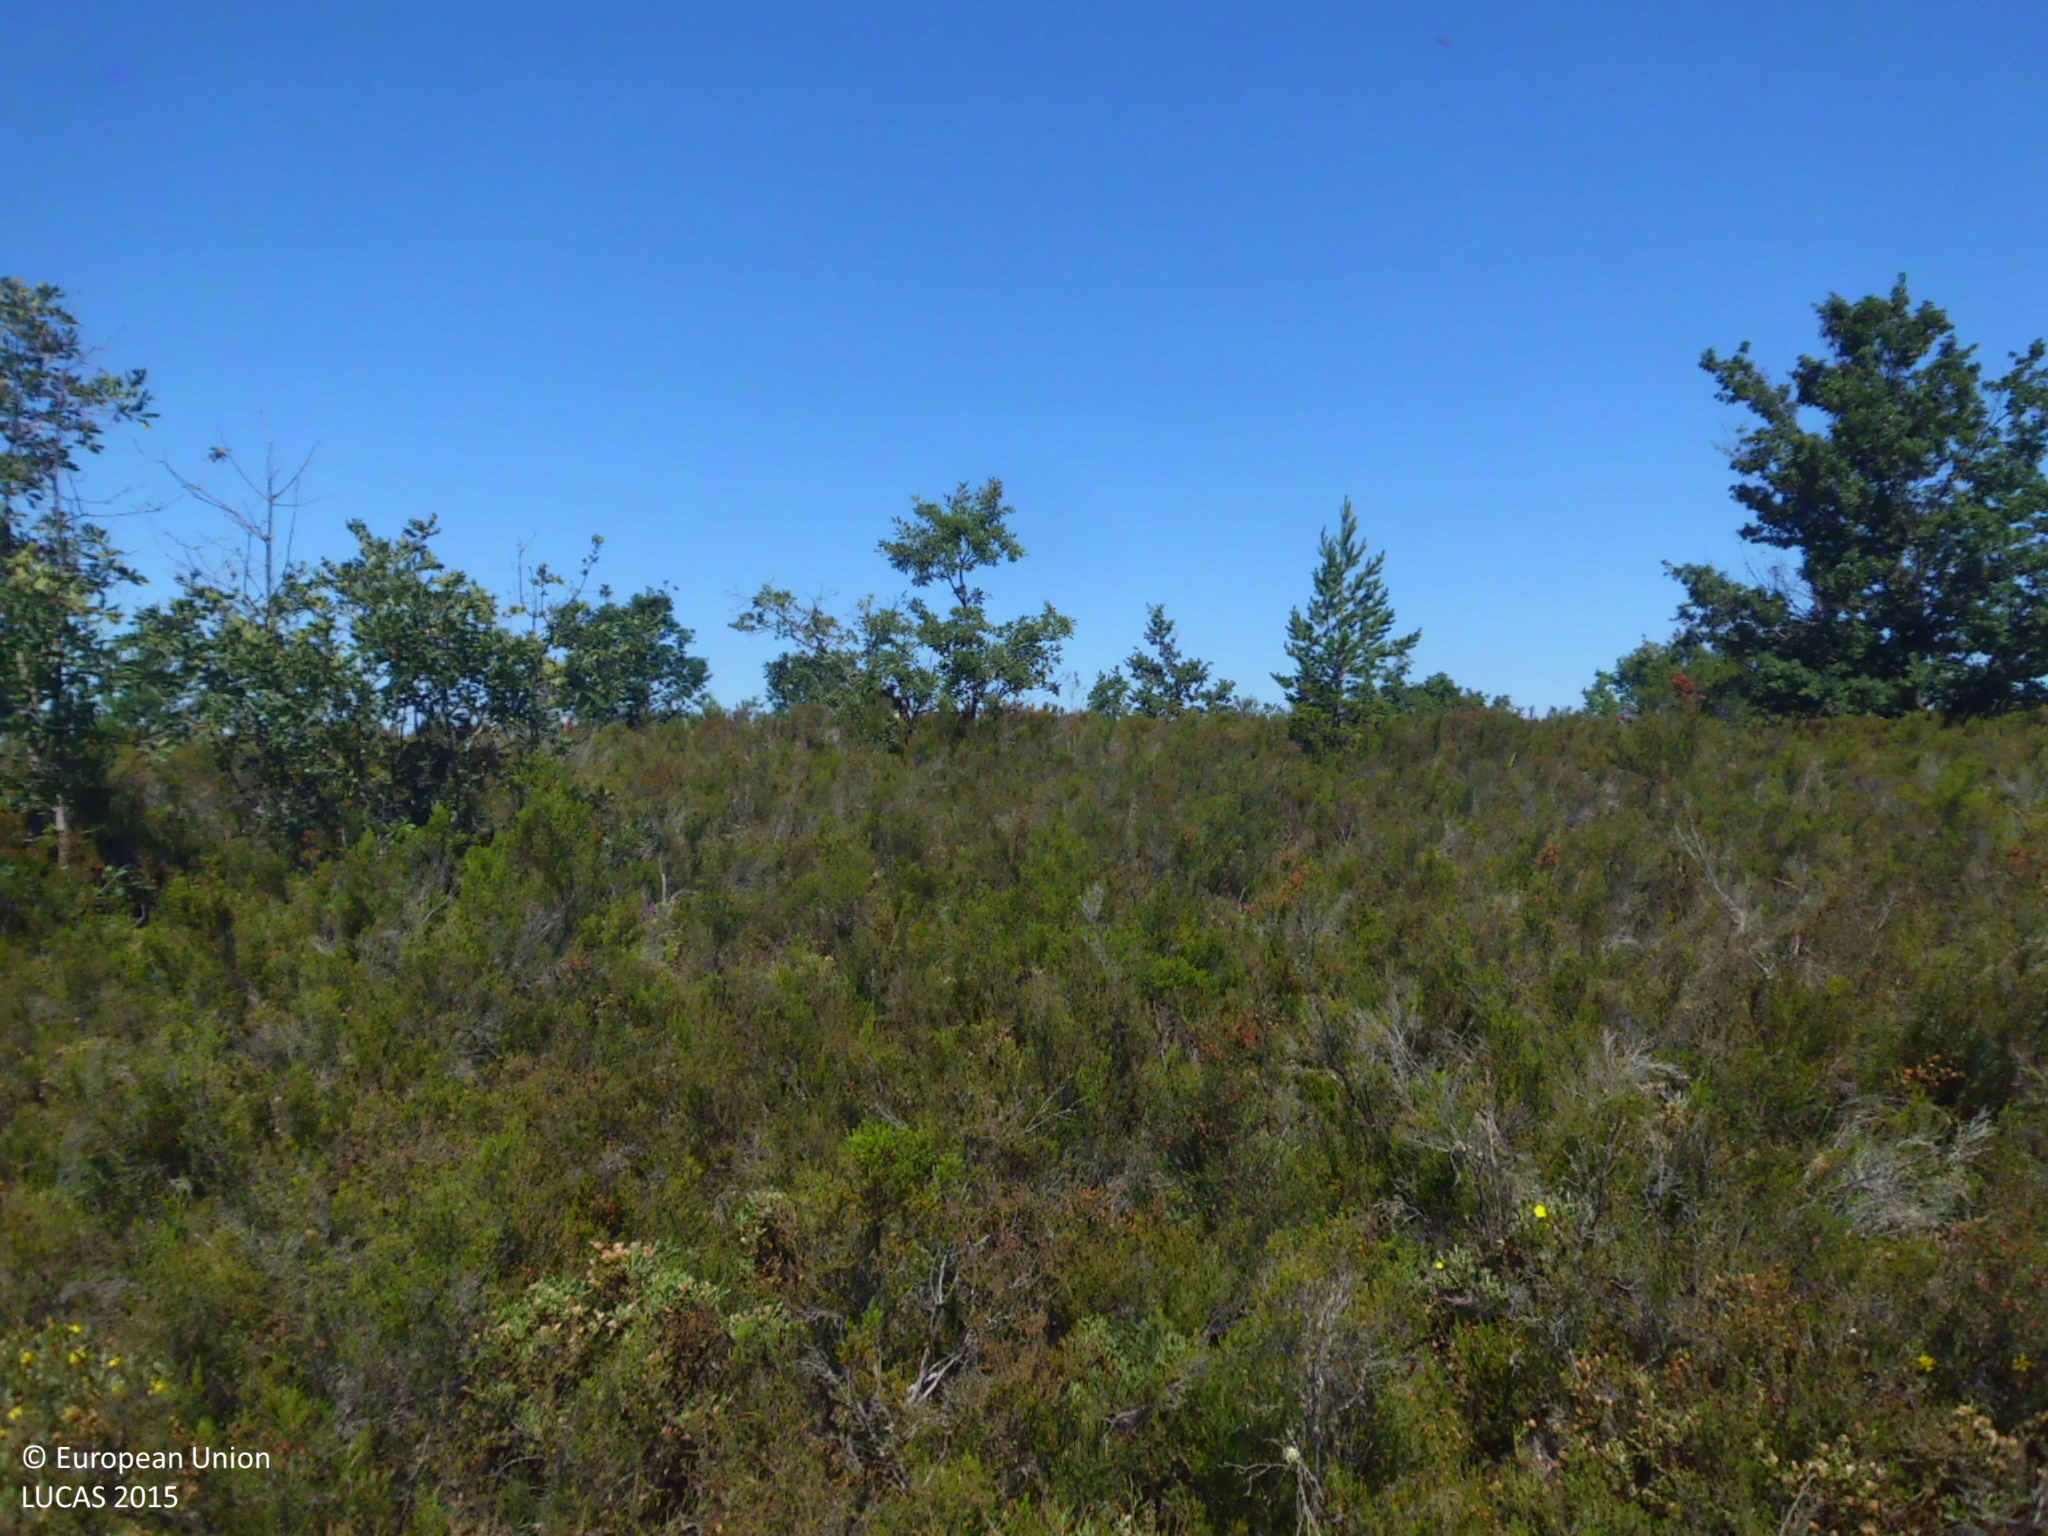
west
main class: Shrubland
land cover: Shrubland without tree cover
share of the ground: > 75 %
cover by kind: shrubs 95 %, herbaceous plants 5 %
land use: Abandoned areas
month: June
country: ES
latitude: 42.7714
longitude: -4.9107
